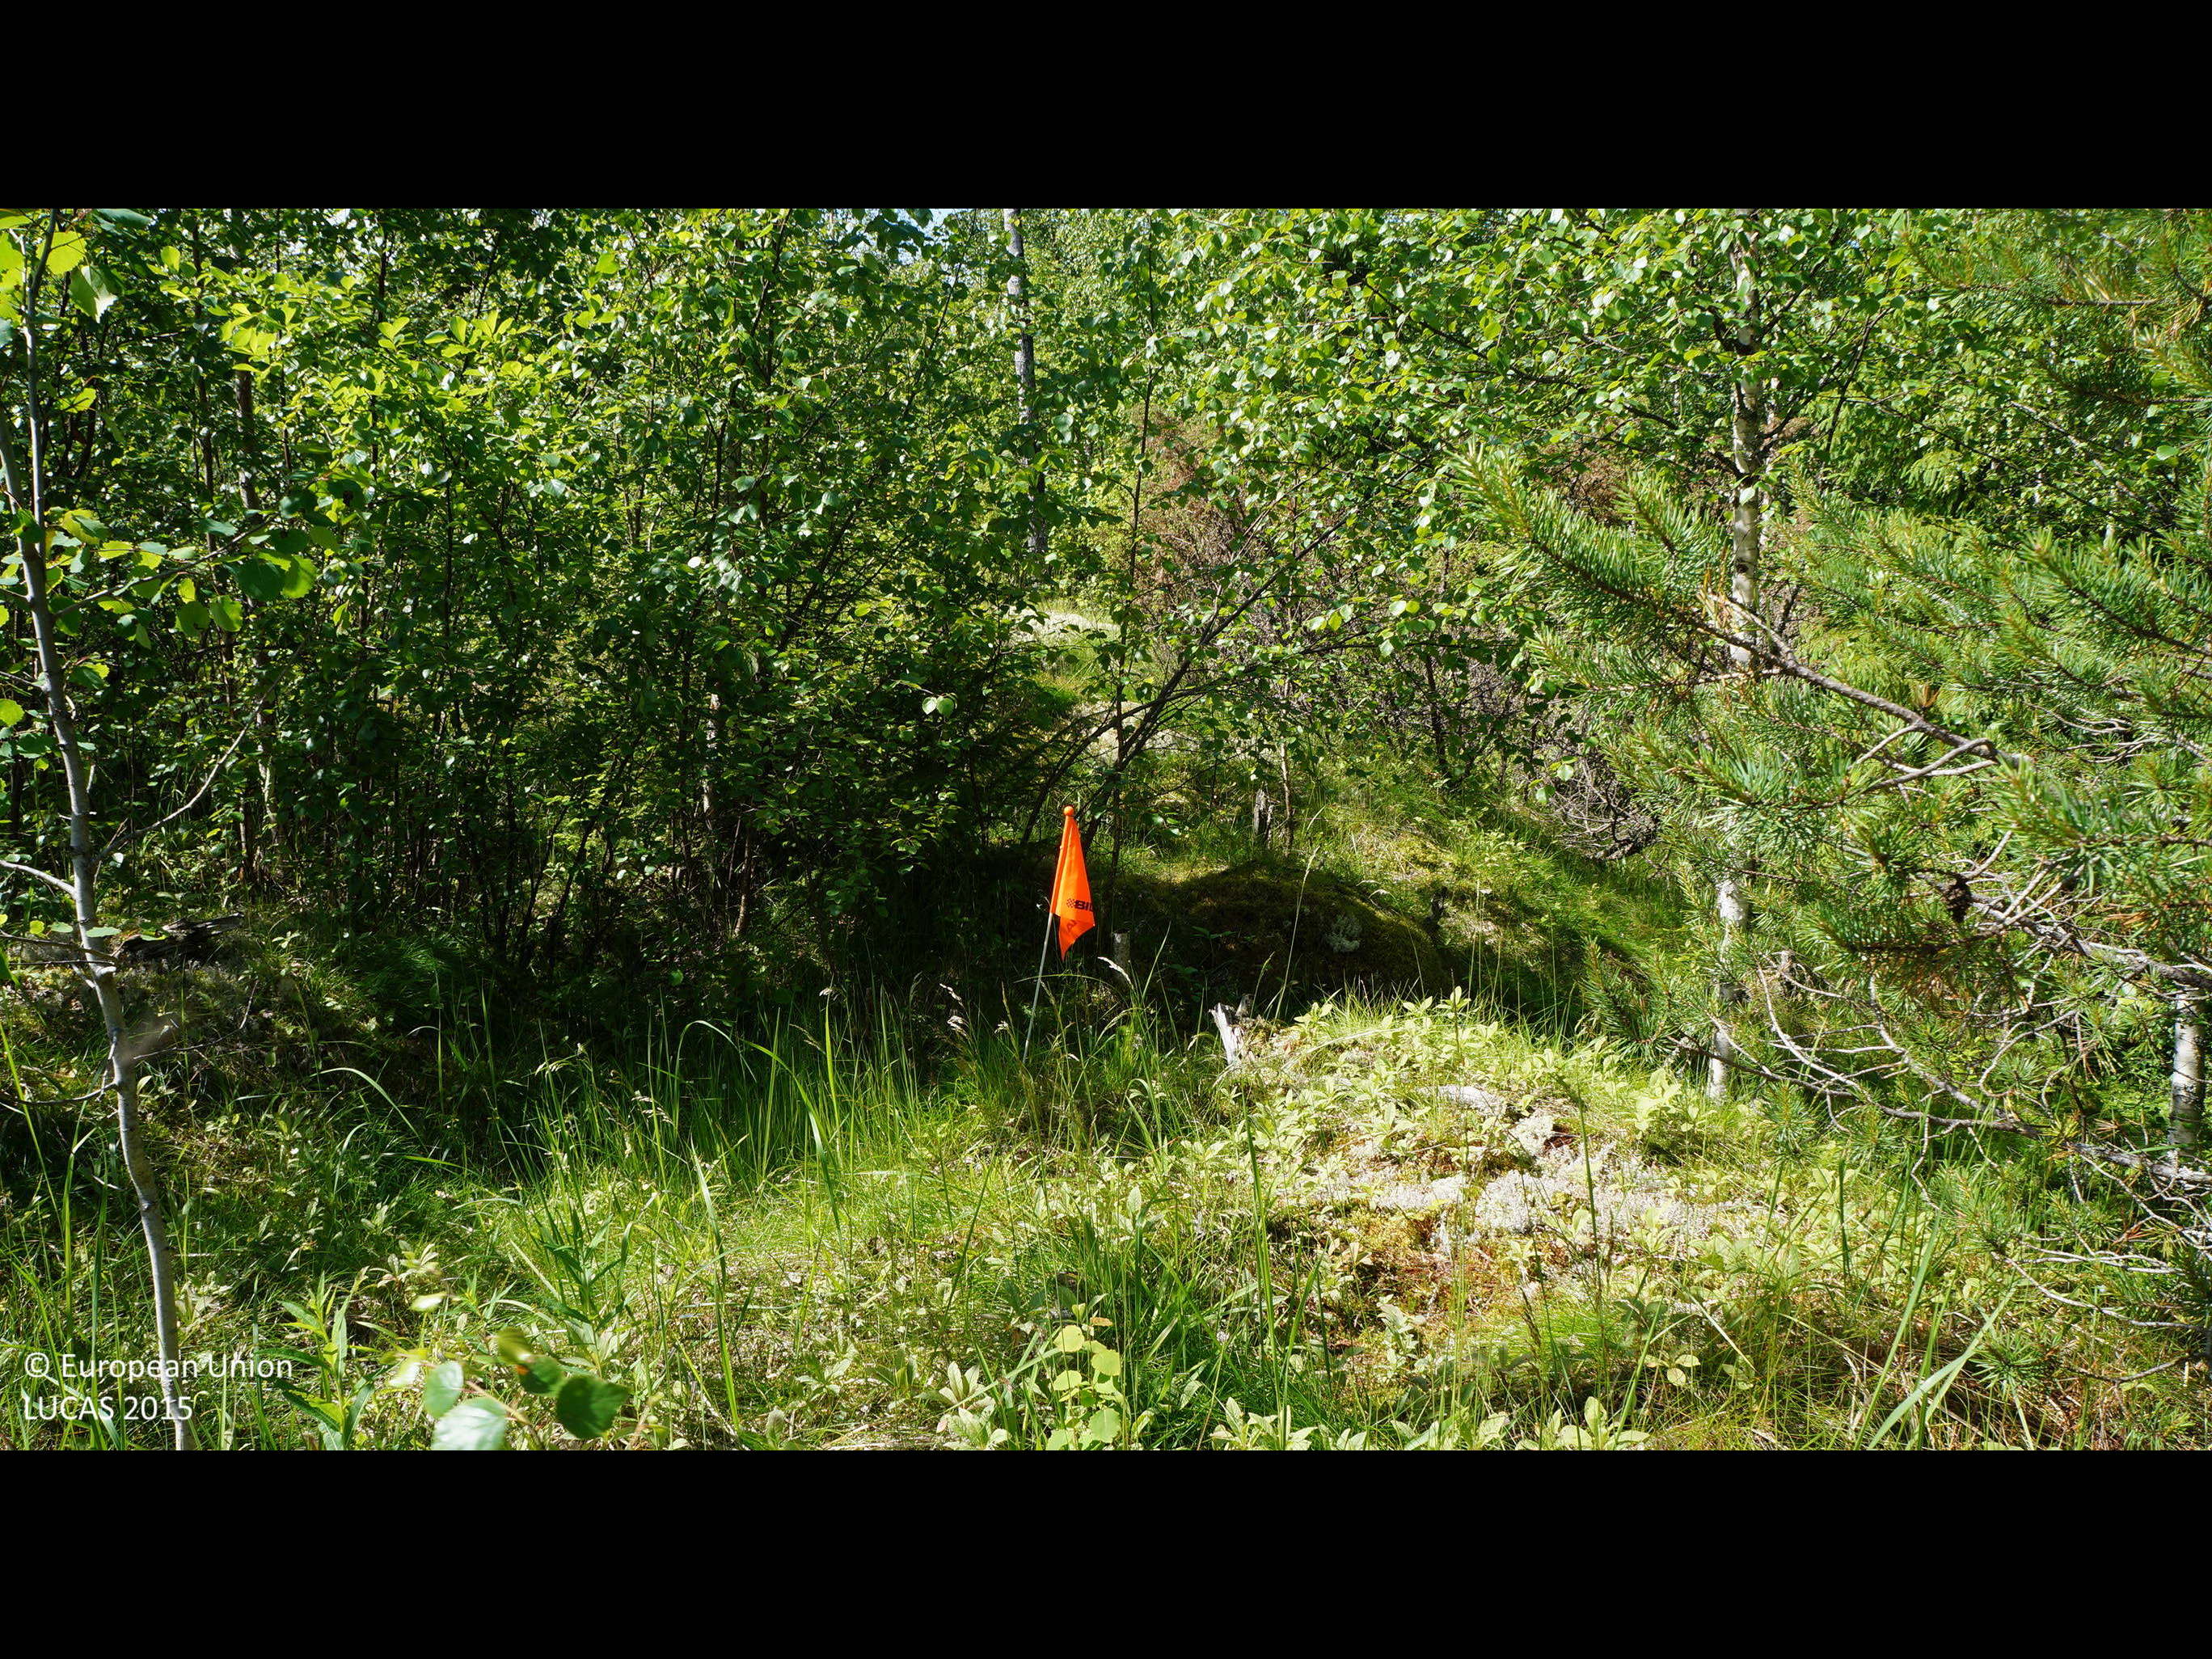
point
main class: Woodland
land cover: Broadleaved woodland
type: boreal forest
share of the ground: 50 - 75 %
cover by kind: broadleaved forest trees 40 %, shrubs 30 %, herbaceous plants 20 %, coniferous forest trees 10 %
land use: Forestry
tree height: > 5 m
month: July
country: FI
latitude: 64.1740
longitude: 24.4530
